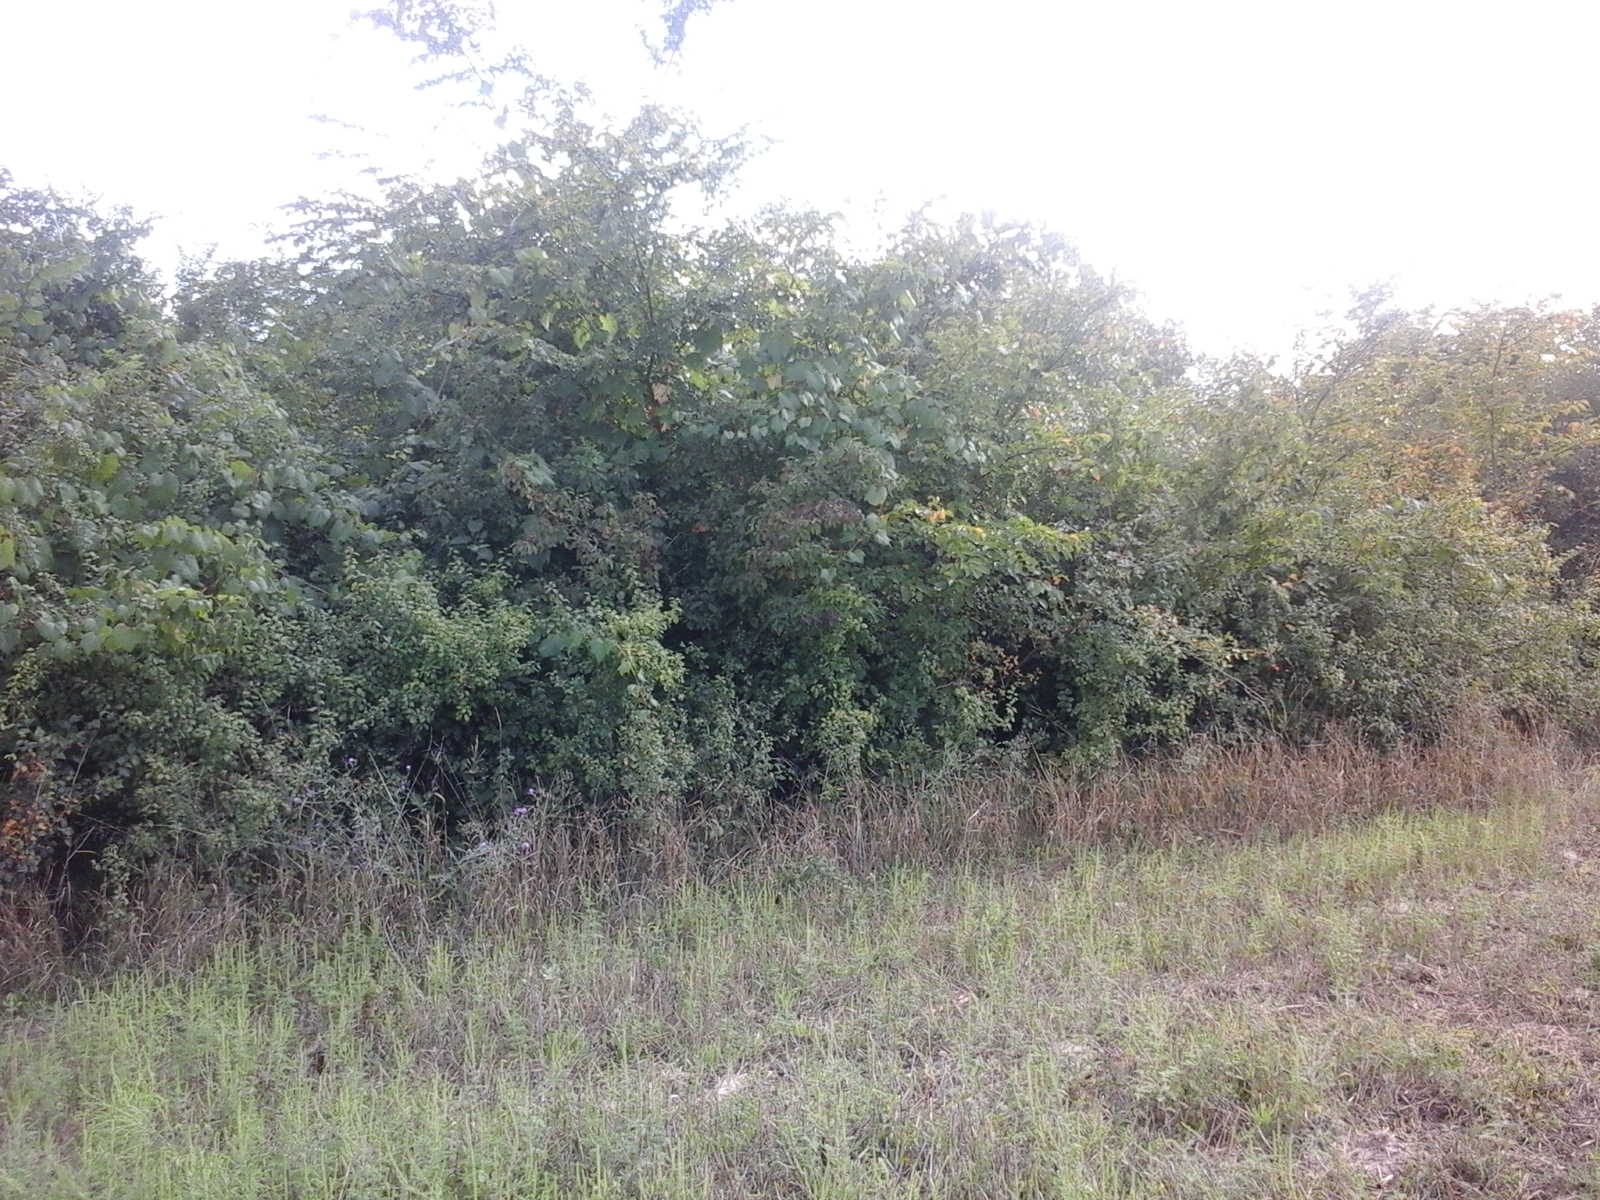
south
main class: Cropland
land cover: Common wheat
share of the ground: 25 - 50 %
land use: Agriculture (excluding fallow land and kitchen gardens)
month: August
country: RO
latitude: 46.7104
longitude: 21.6698
